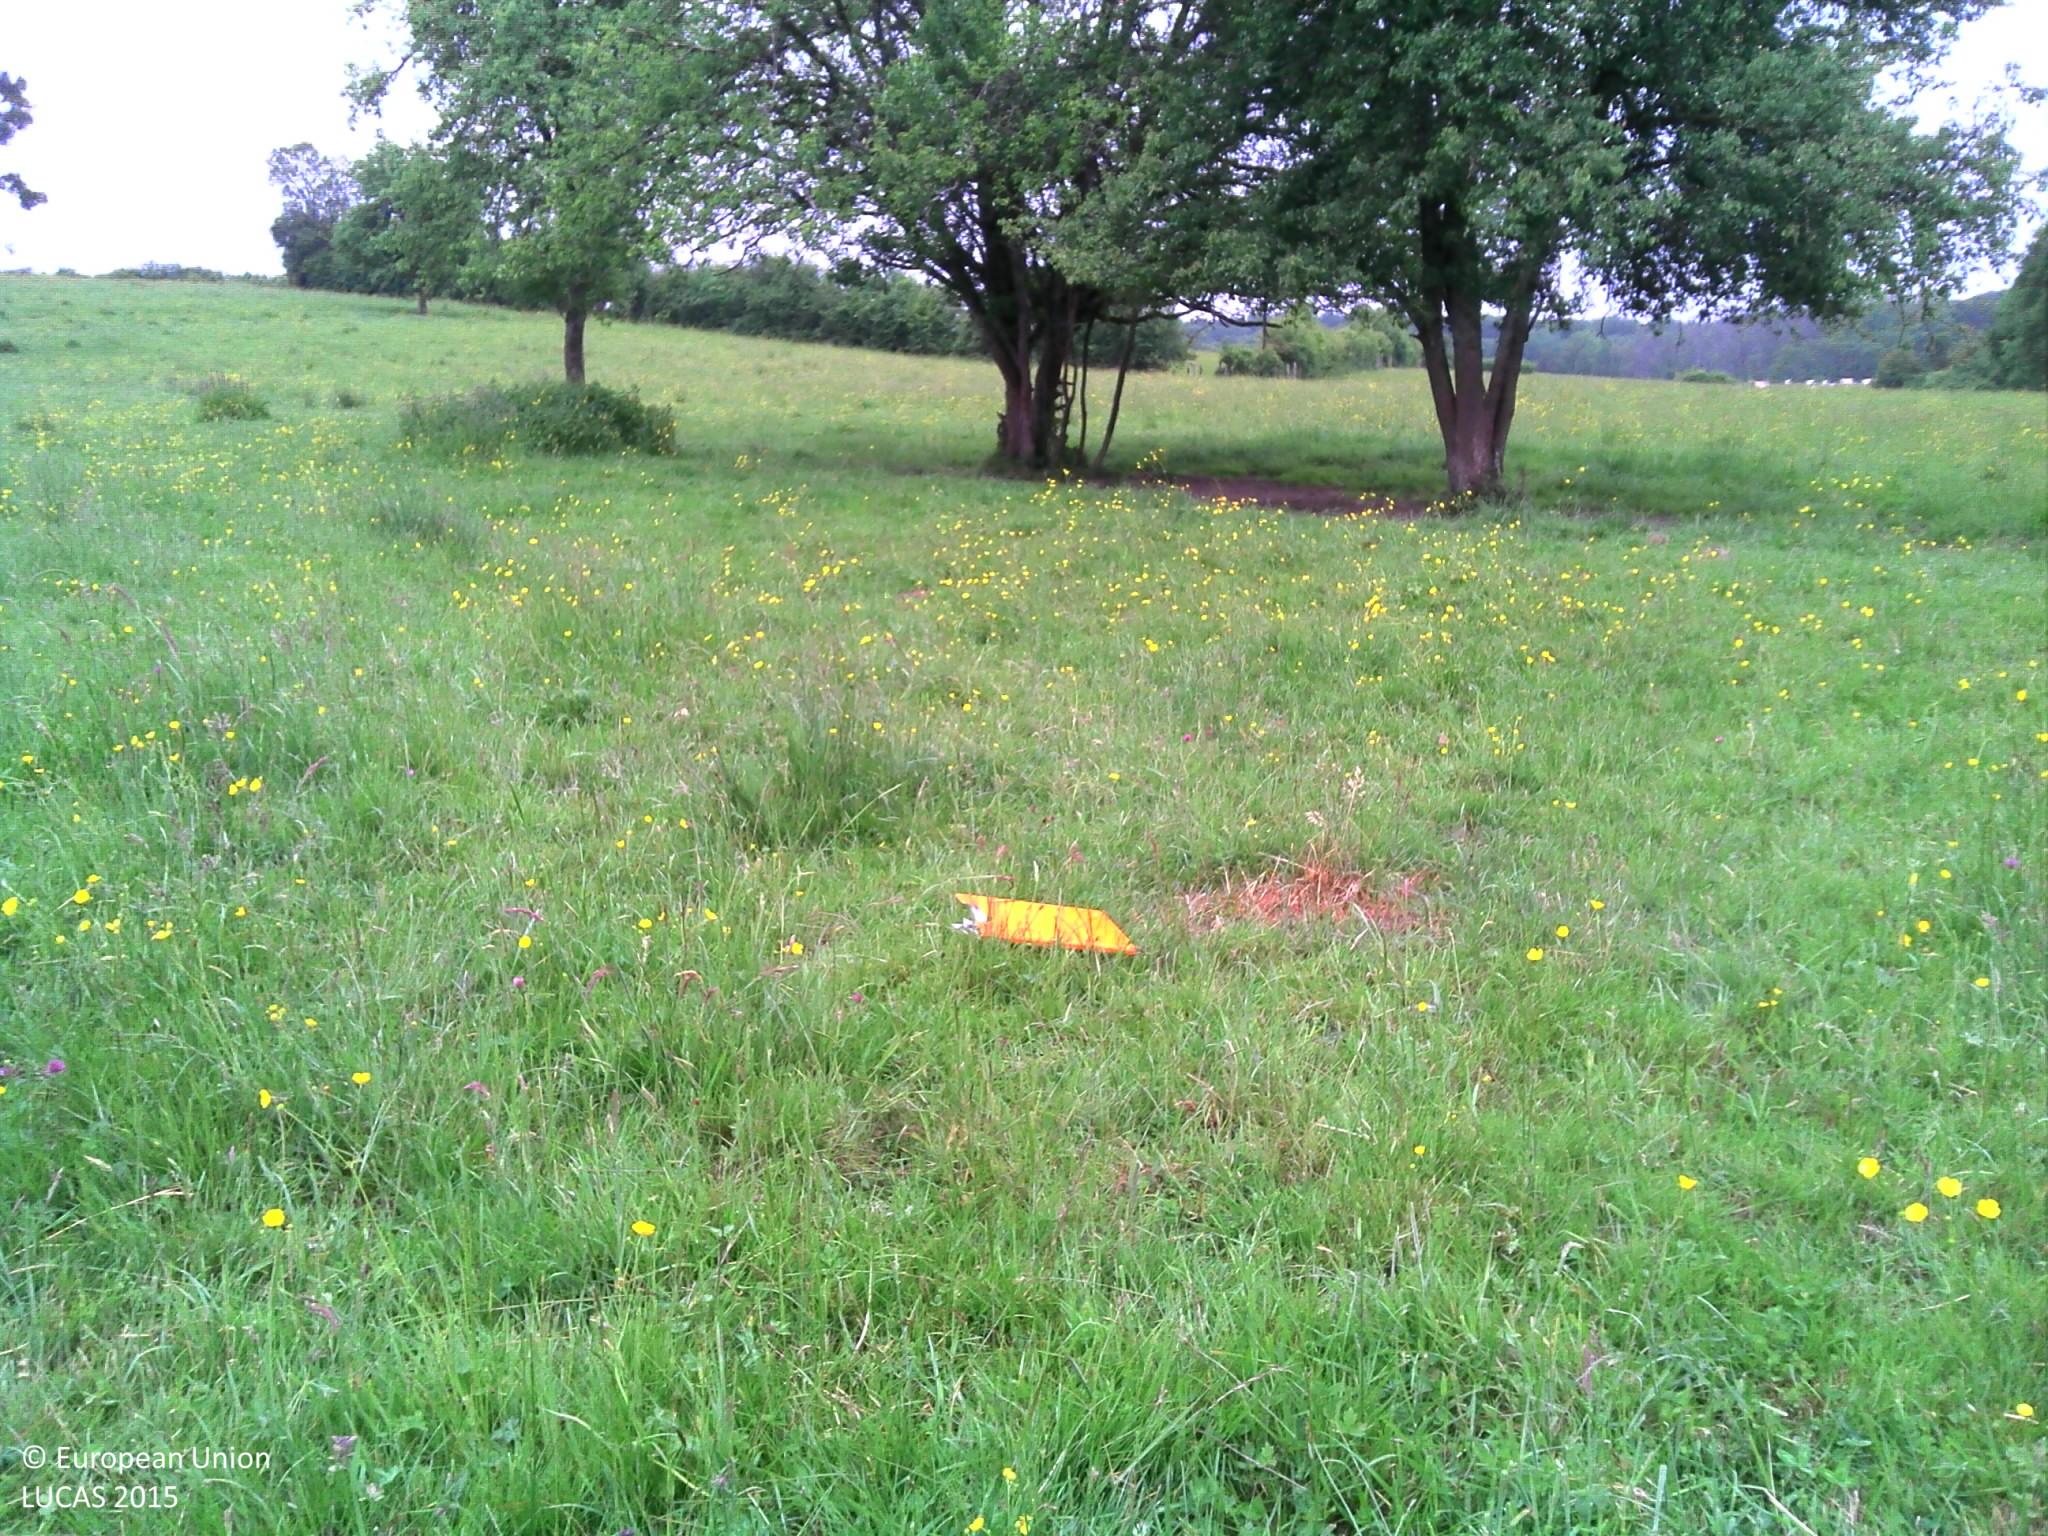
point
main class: Grassland
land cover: Grassland with sparse tree/shrub cover
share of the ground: > 75 %
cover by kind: herbaceous plants 95 %, broadleaved forest trees 5 %
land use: Agriculture (excluding fallow land and kitchen gardens)
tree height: > 5 m
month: May
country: FR
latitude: 47.9405
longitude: 6.1587
